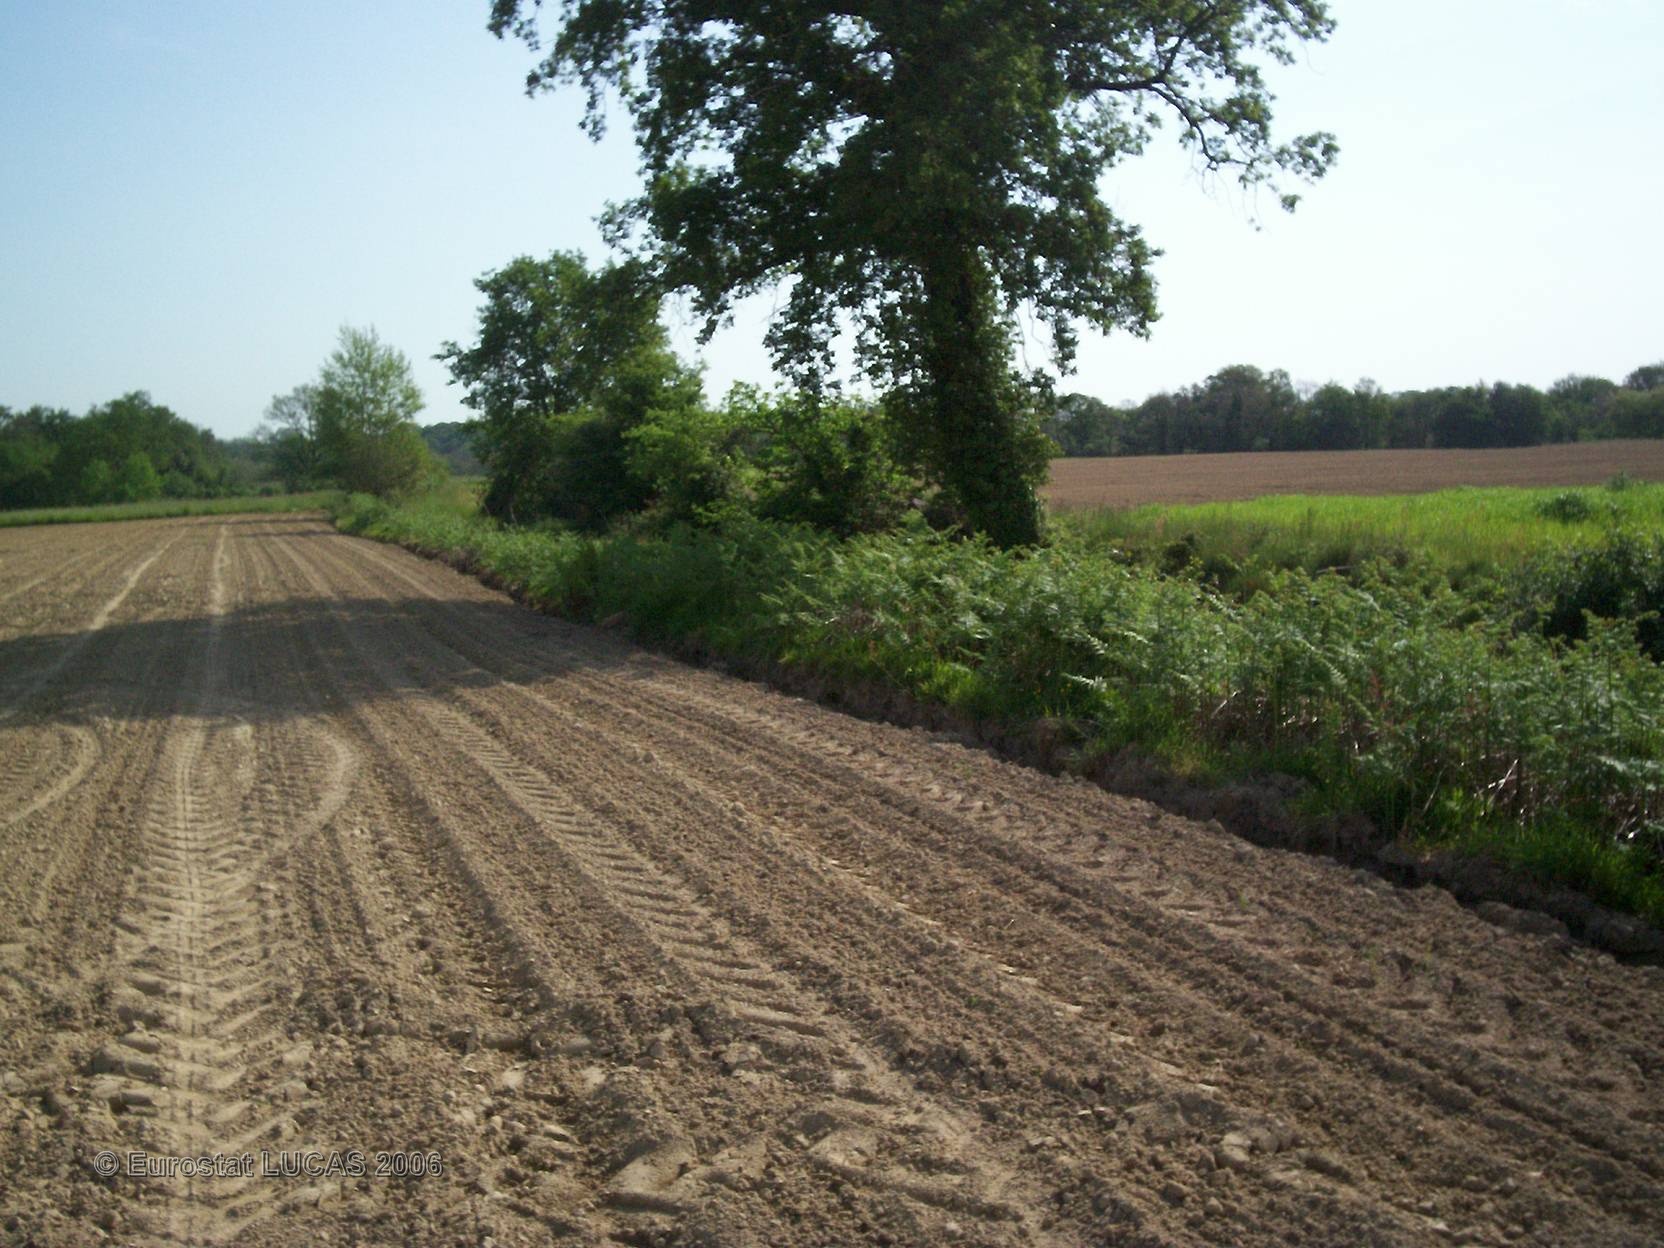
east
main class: Cropland
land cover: Maize
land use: Agriculture (excluding fallow land and kitchen gardens)
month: June
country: FR
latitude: 43.7380
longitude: -0.3775
